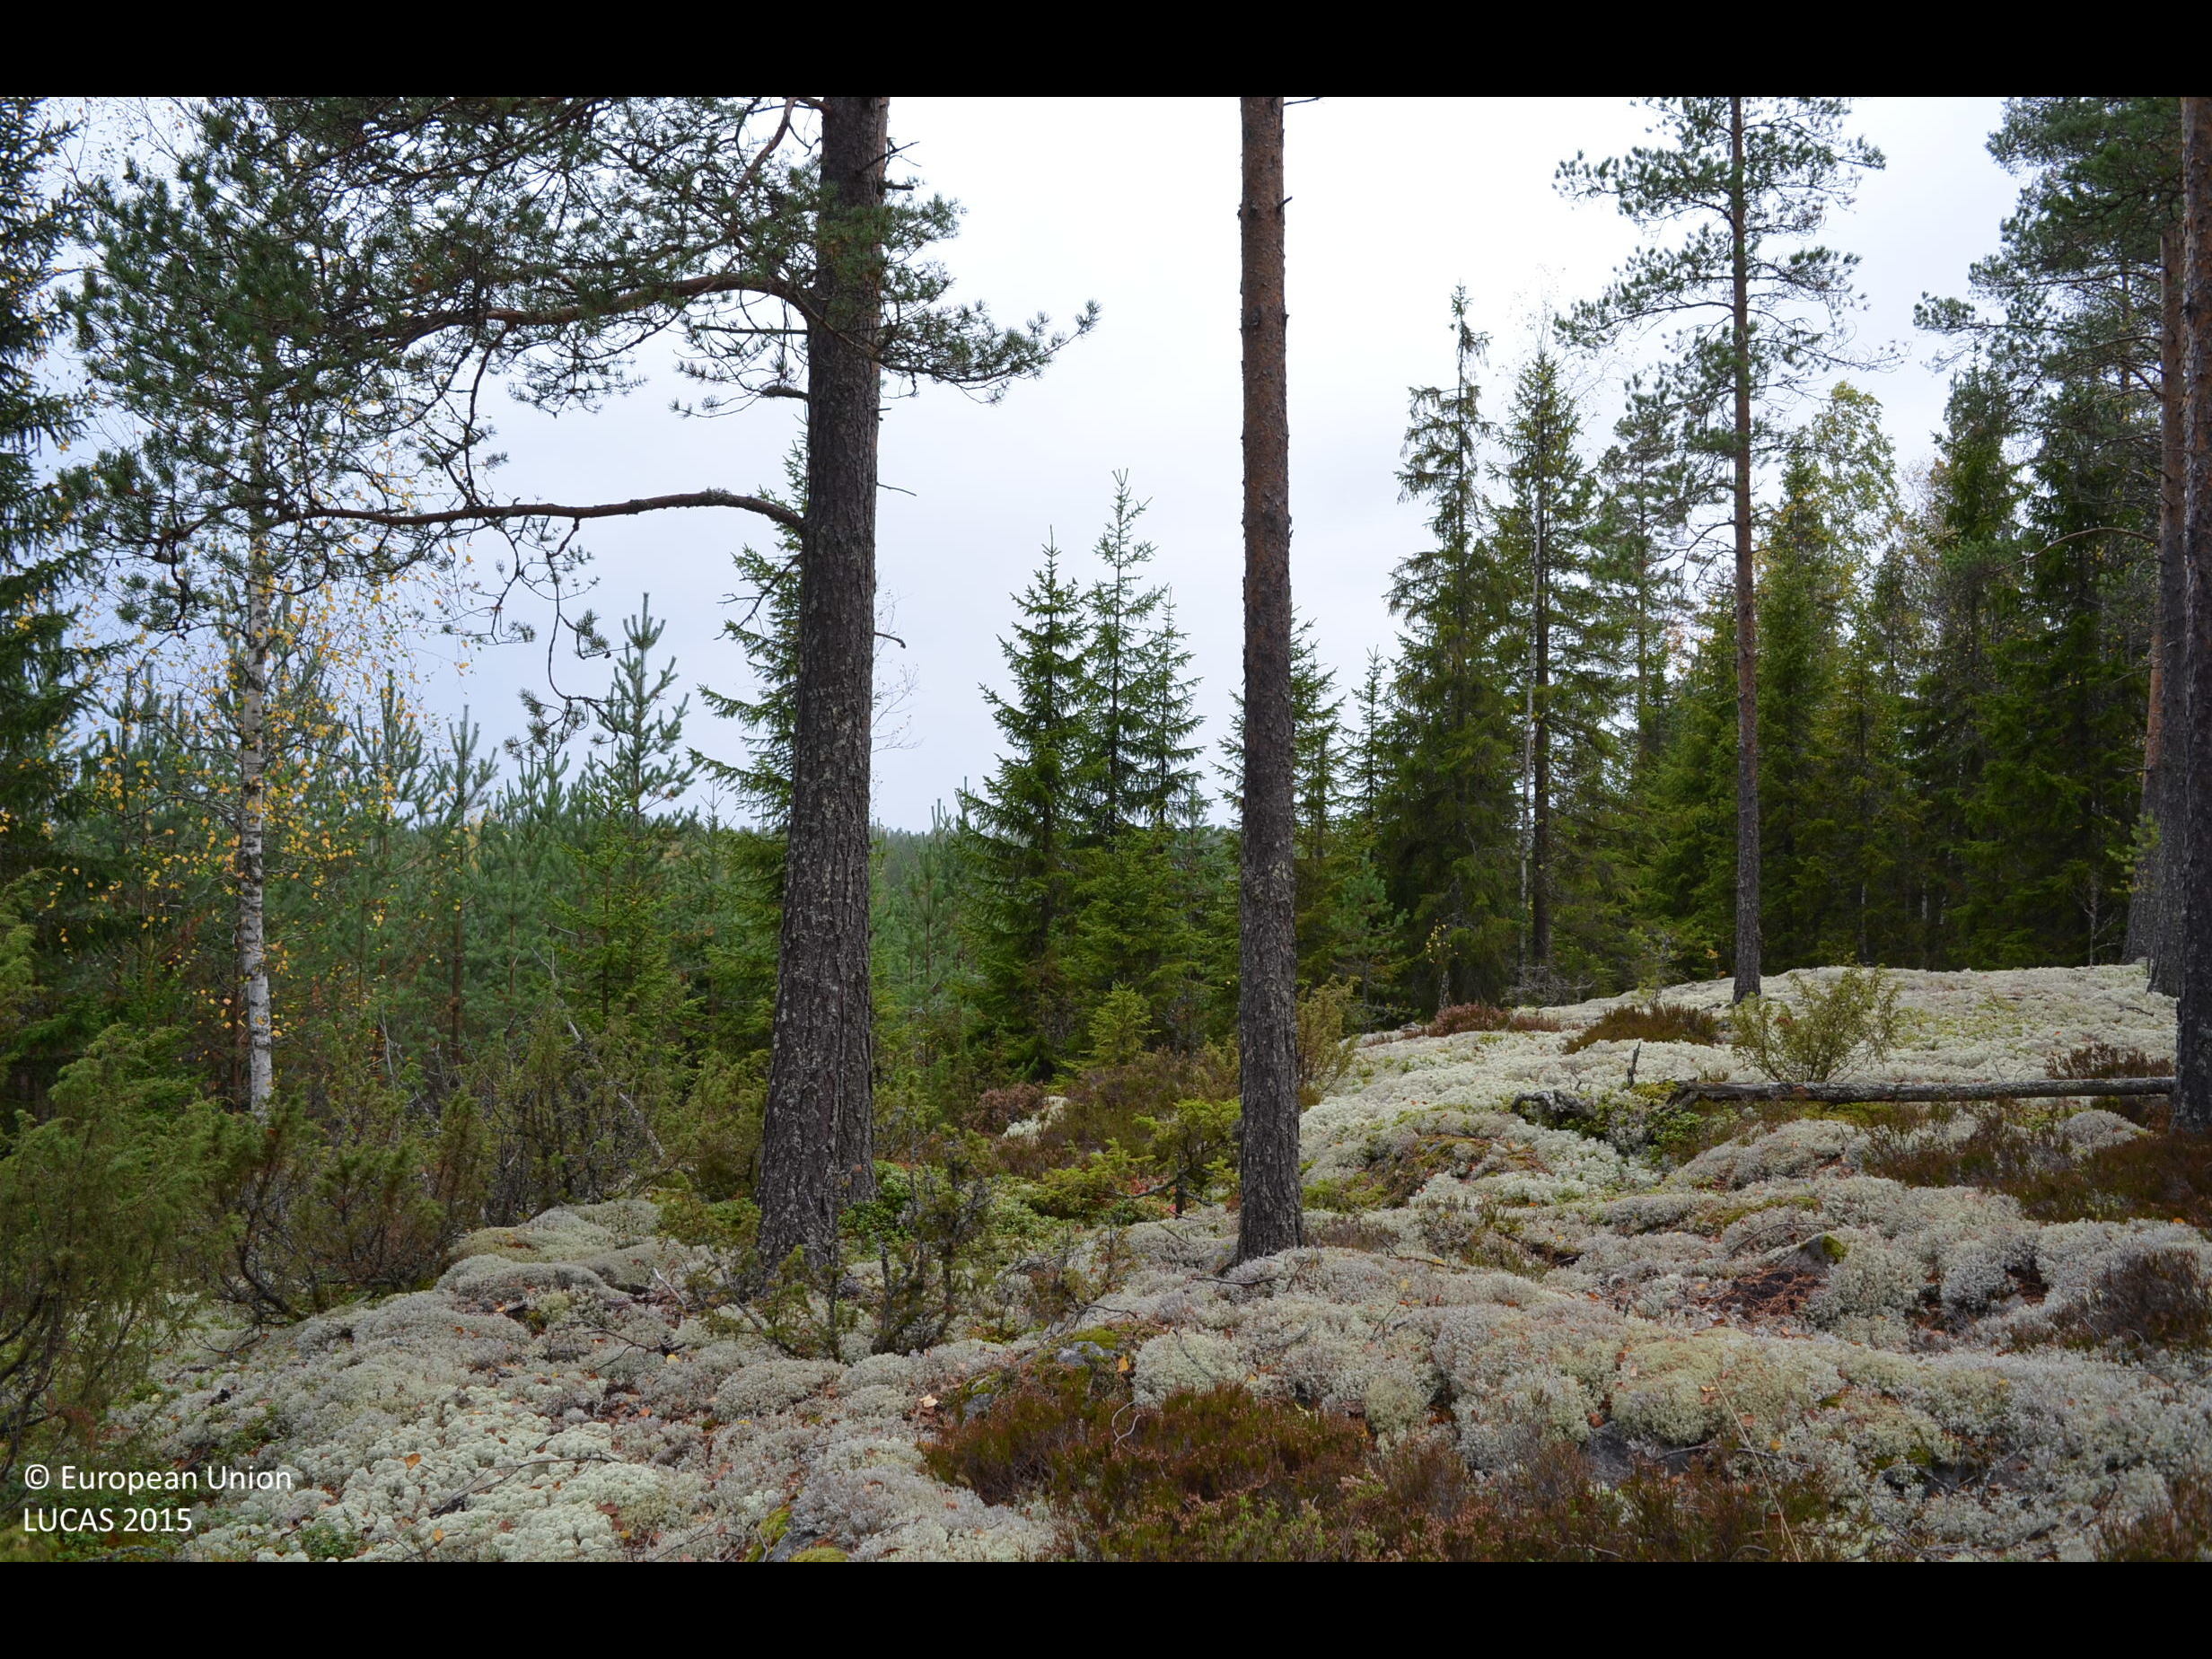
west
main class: Woodland
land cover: Other coniferous woodland
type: boreal forest
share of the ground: 50 - 75 %
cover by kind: coniferous forest trees 50 %, lichens and mosses 25 %, broadleaved forest trees 10 %, shrubs 10 %, unconsolidated bare surface 5 %
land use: Forestry
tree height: > 5 m
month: September
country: FI
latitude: 62.4380
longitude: 23.7332
